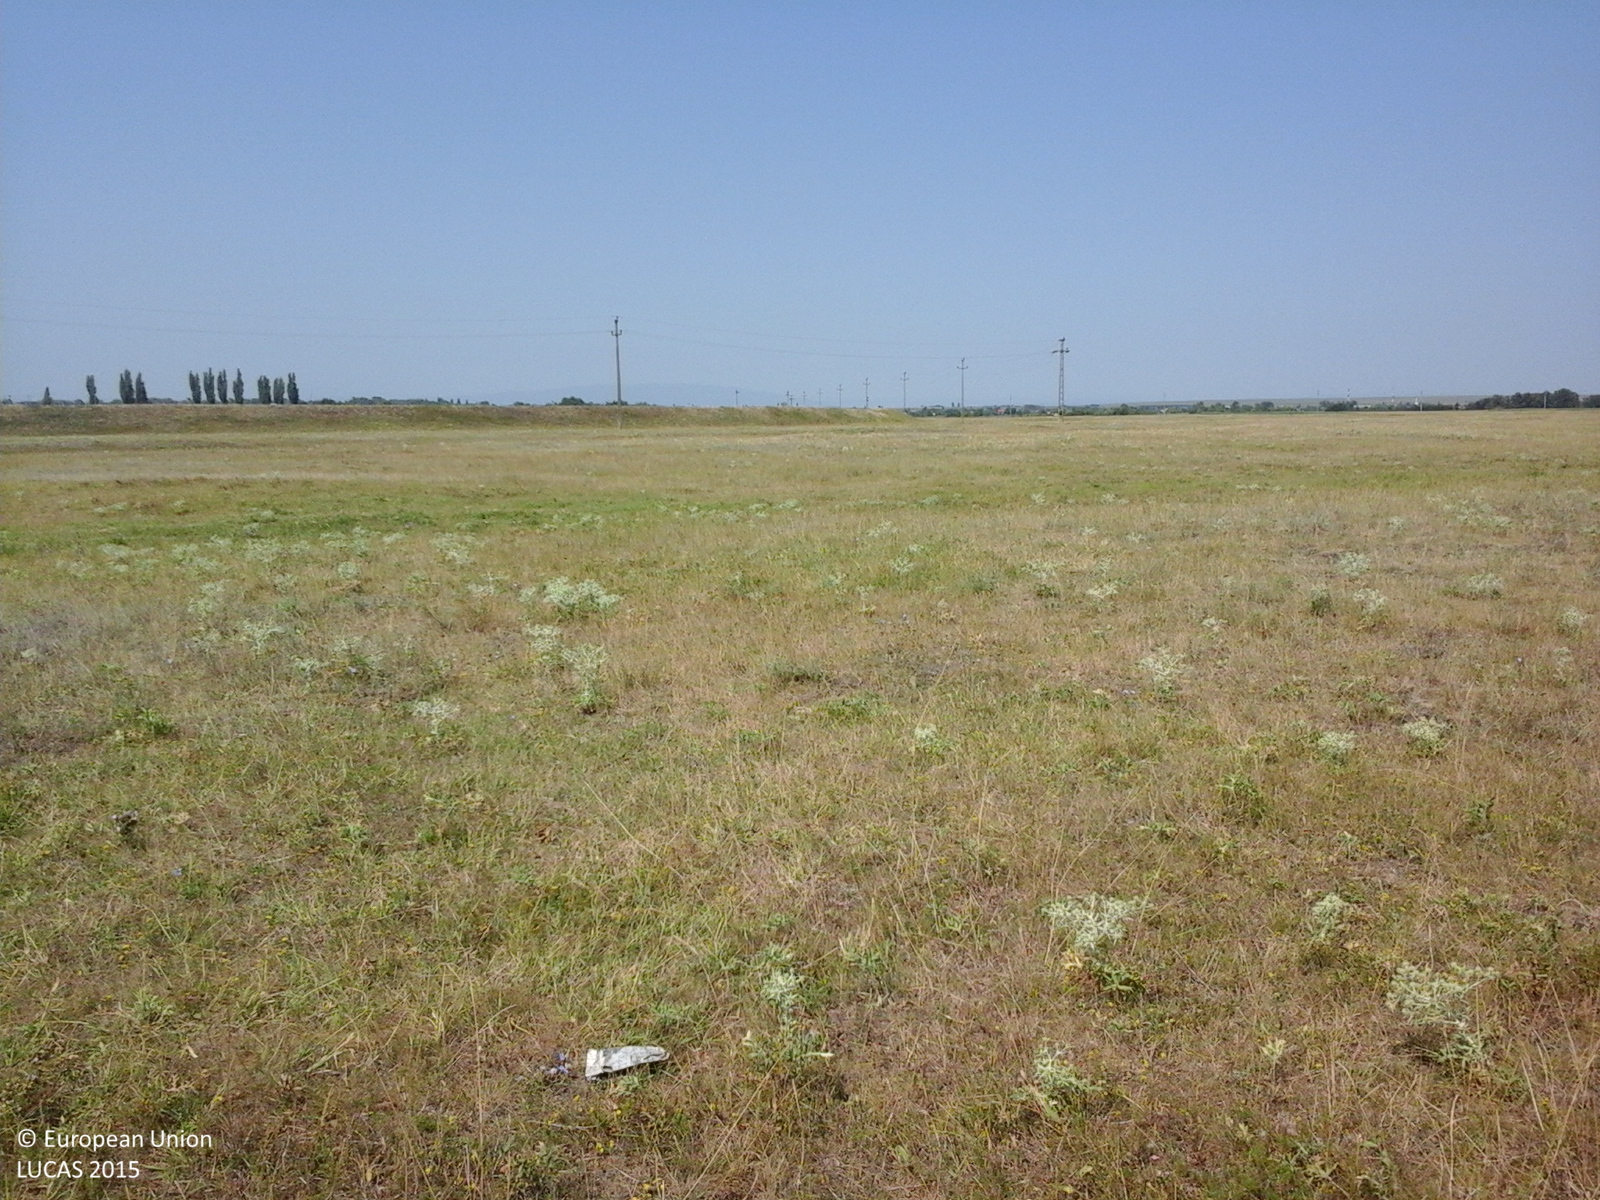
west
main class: Grassland
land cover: Grassland without tree/shrub cover
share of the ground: > 75 %
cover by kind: herbaceous plants 100 %
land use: Agriculture (excluding fallow land and kitchen gardens)
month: July
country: RO
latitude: 45.8593
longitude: 27.4532
